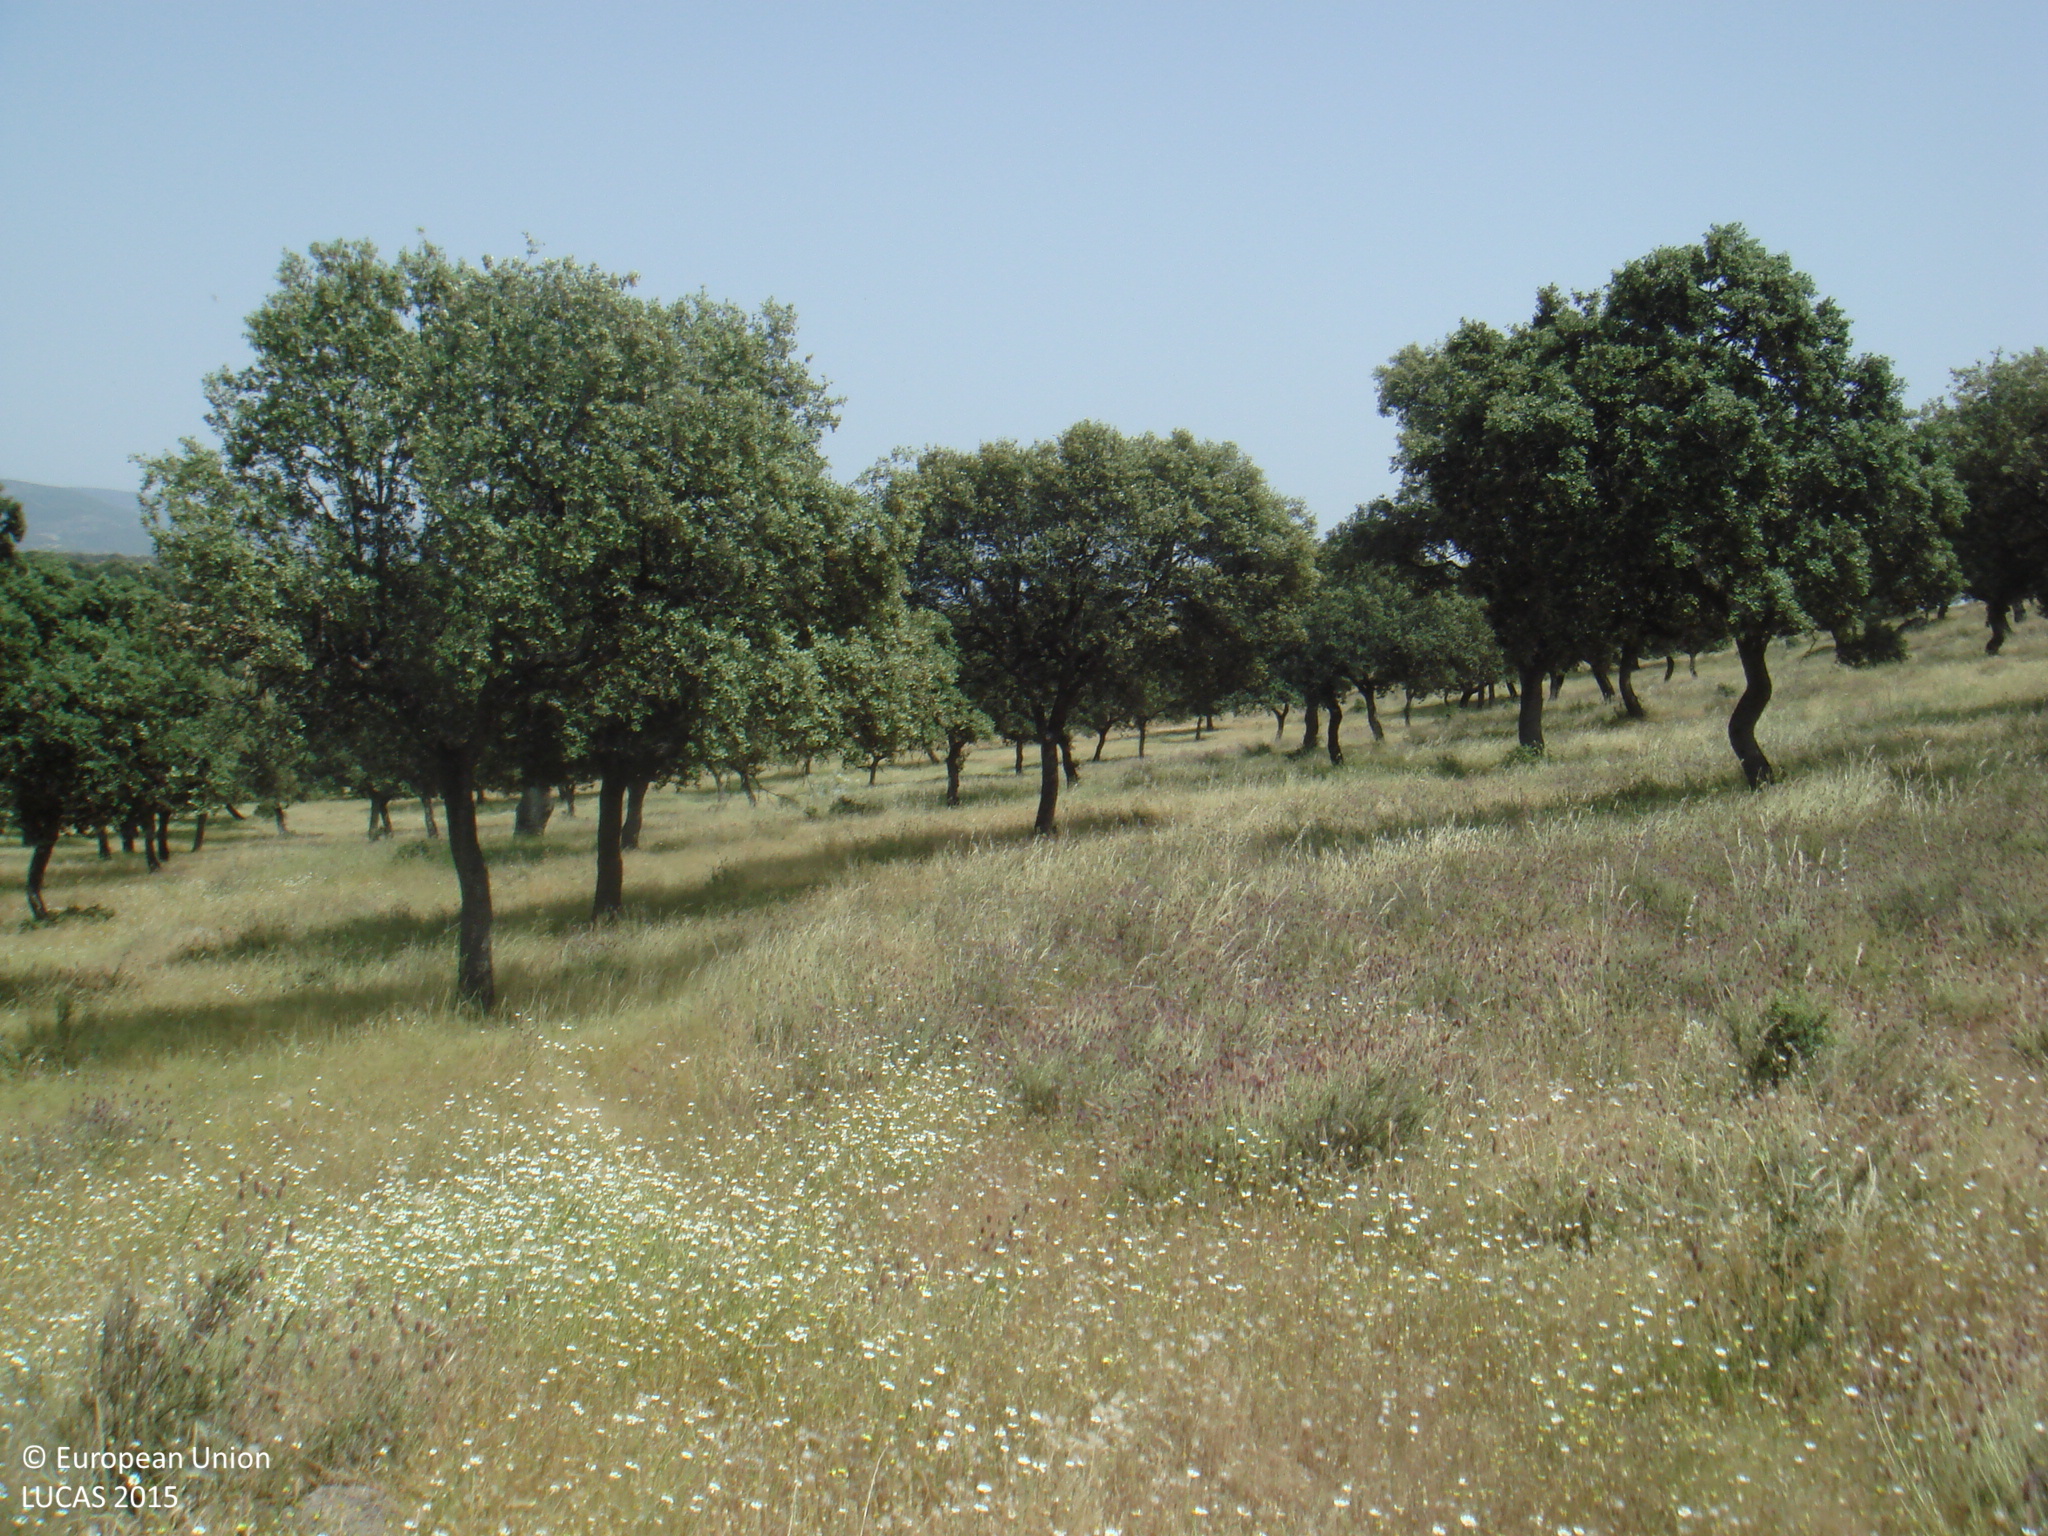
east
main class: Woodland
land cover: Broadleaved woodland
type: broadleaved evergreen forest
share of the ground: 25 - 50 %
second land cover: Spontaneously vegetated surfaces
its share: > 75 %
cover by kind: broadleaved forest trees 50 %, herbaceous plants 50 %
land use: Forestry
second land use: Agriculture (excluding fallow land and kitchen gardens)
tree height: > 5 m
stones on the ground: 10 - 25 %
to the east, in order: Broadleaved woodland; Spontaneously vegetated surfaces; Fences; Broadleaved woodland
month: May
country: ES
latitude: 38.5369
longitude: -4.7666
